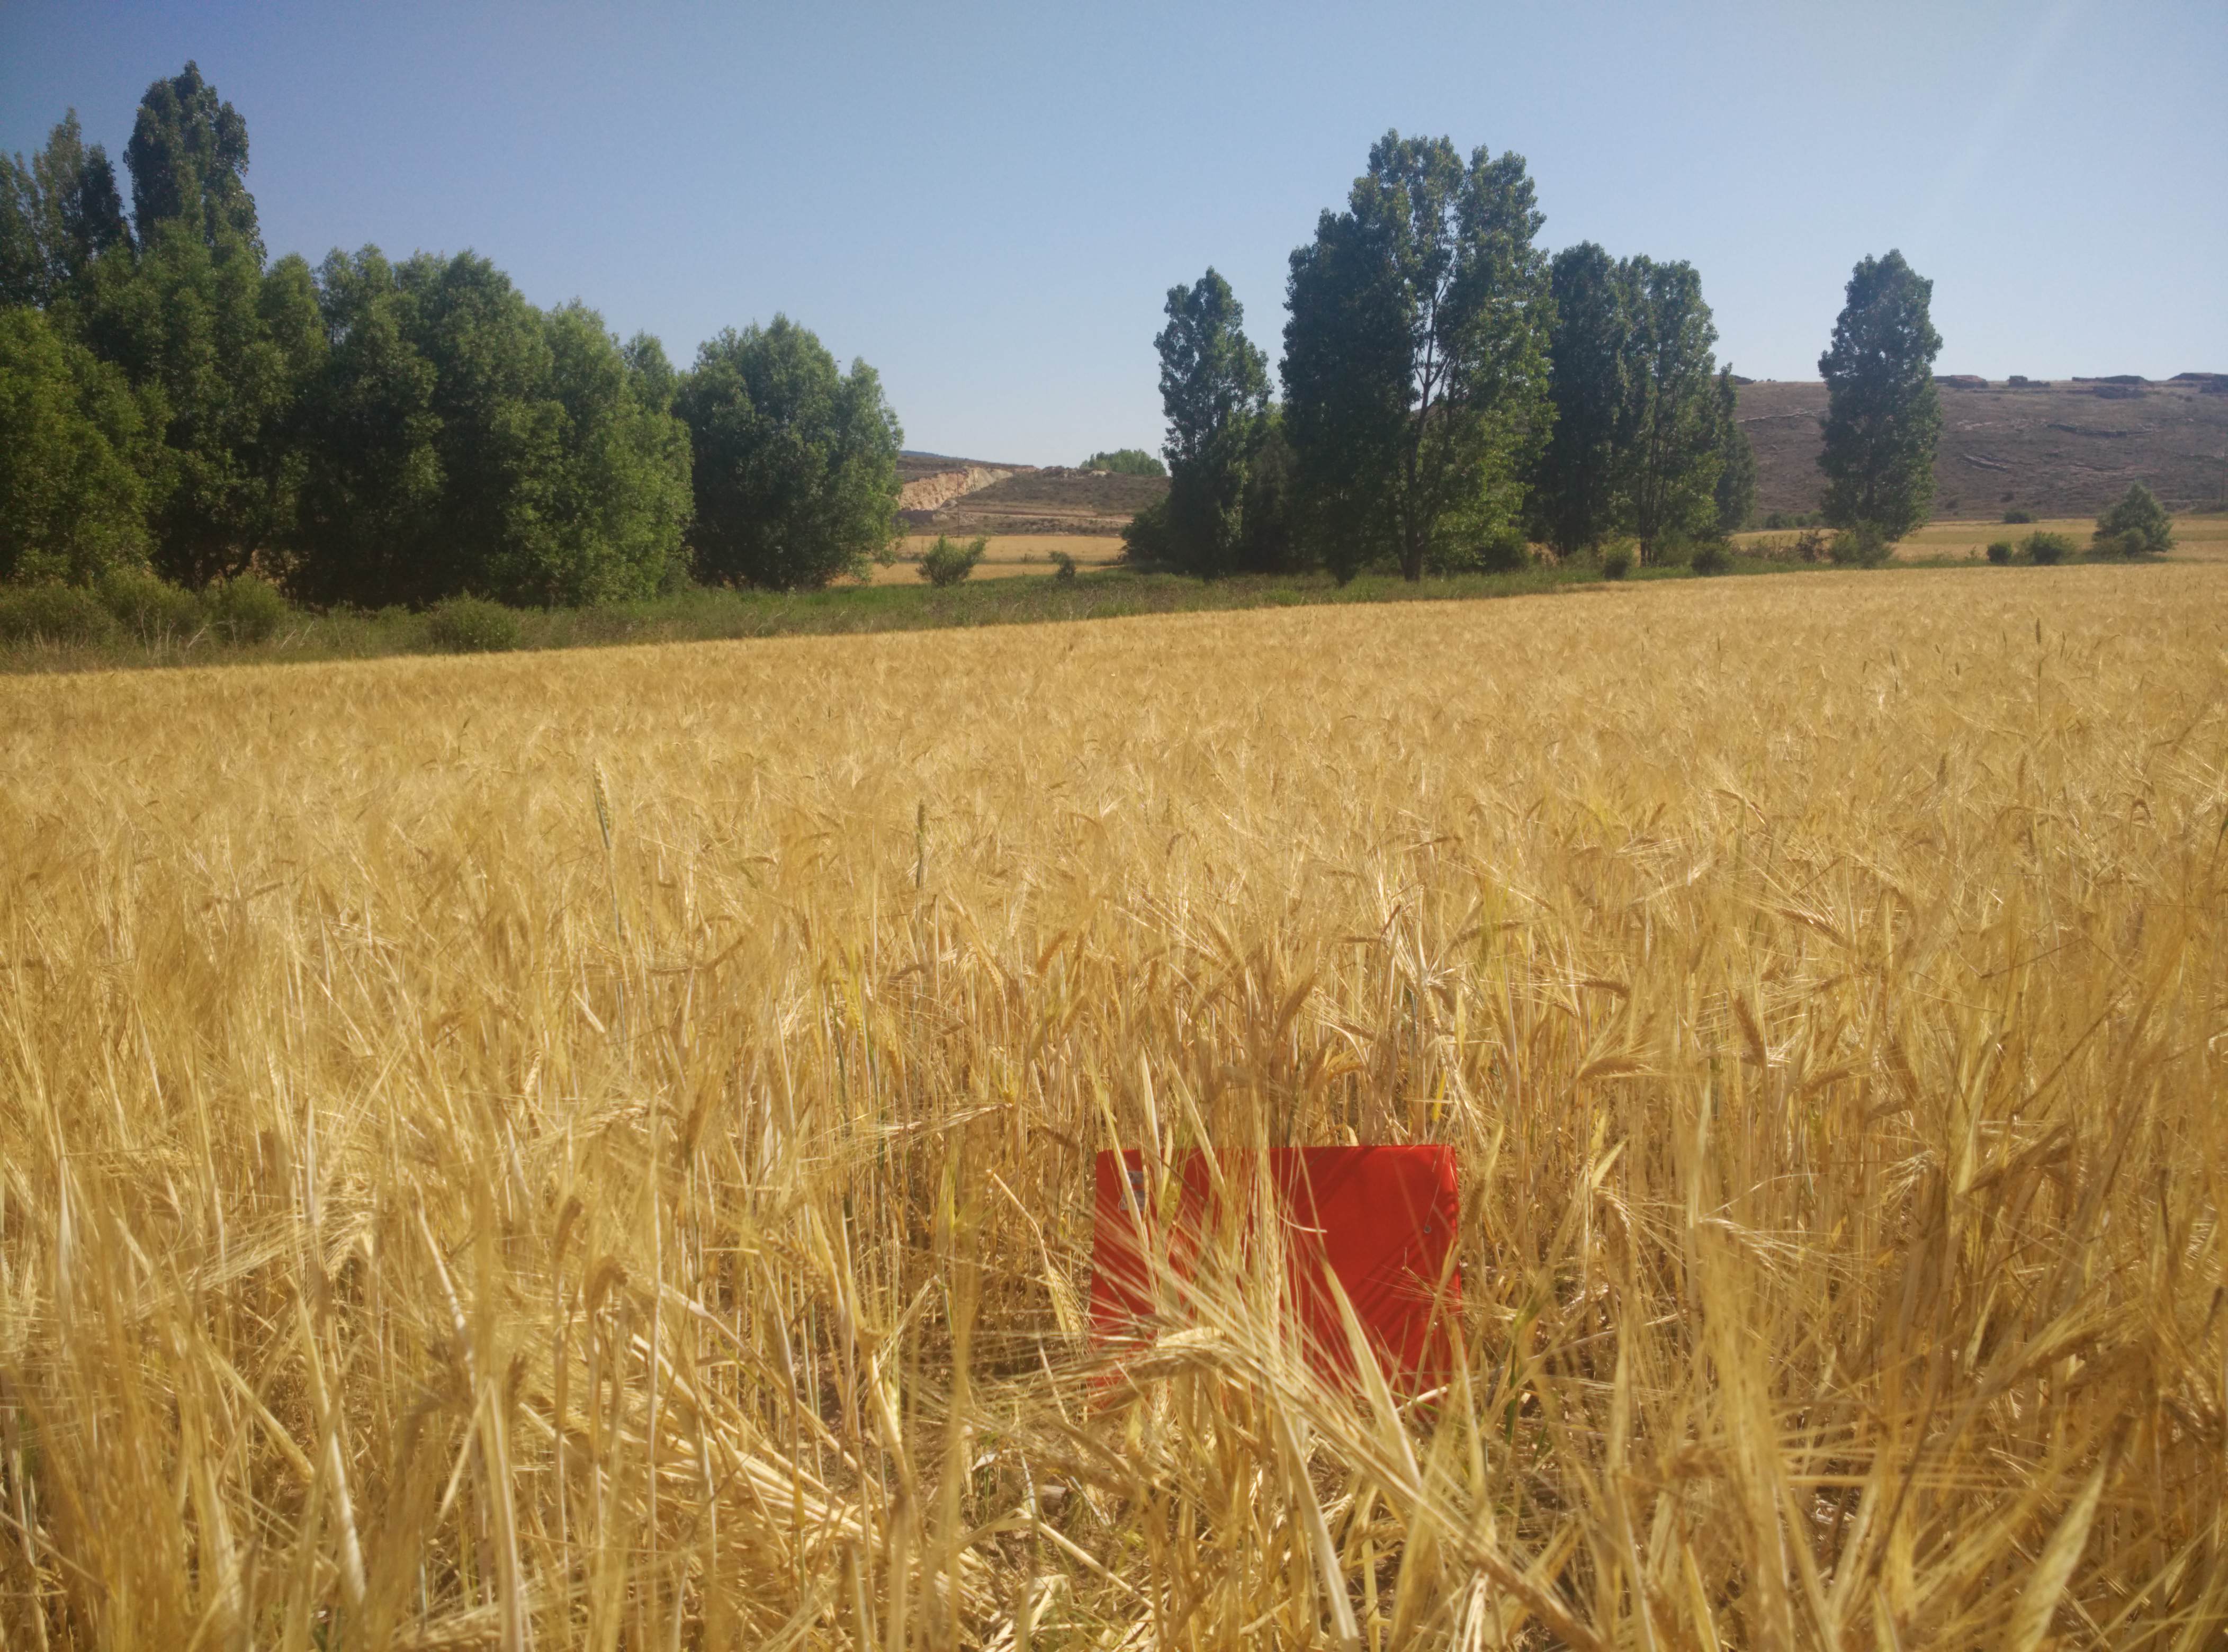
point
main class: Cropland
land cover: Barley
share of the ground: > 75 %
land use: Agriculture (excluding fallow land and kitchen gardens)
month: June
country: ES
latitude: 40.8161
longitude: -1.7697
